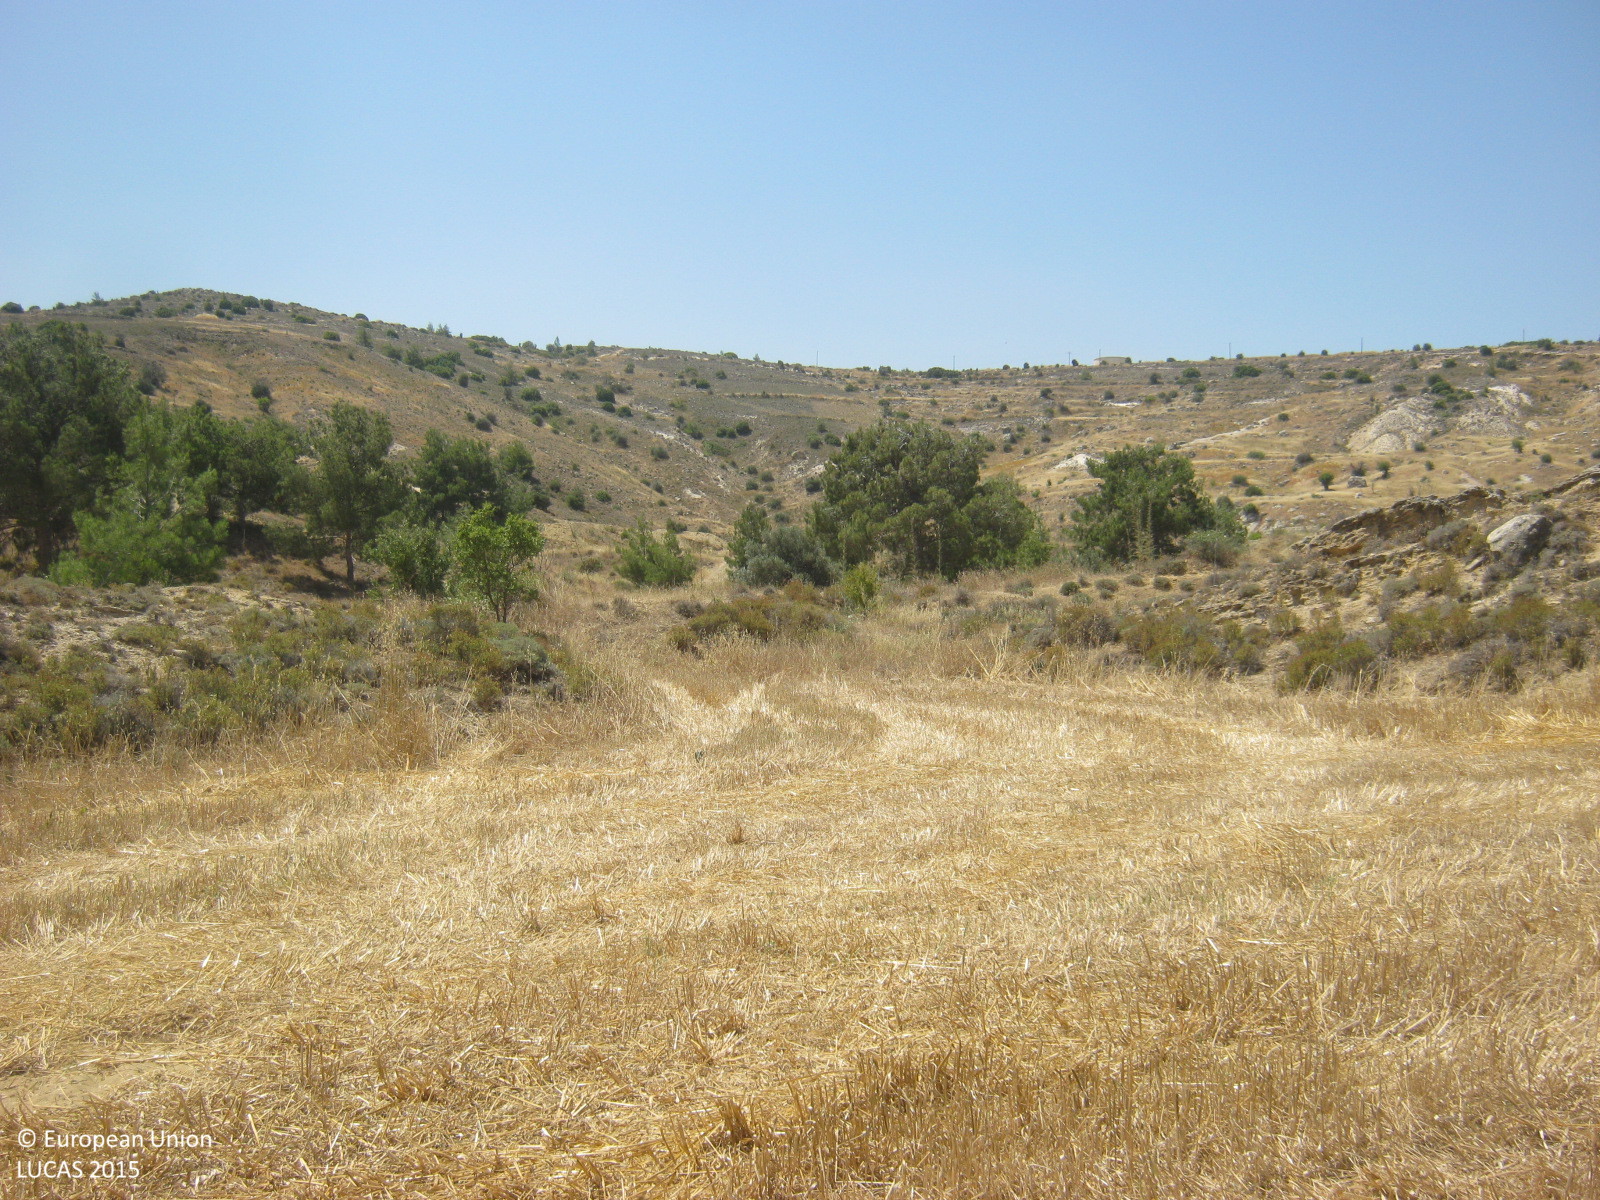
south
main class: Cropland
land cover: Common wheat
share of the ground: < 10 %
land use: Agriculture (excluding fallow land and kitchen gardens)
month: June
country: CY
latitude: 35.0552
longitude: 33.1515
